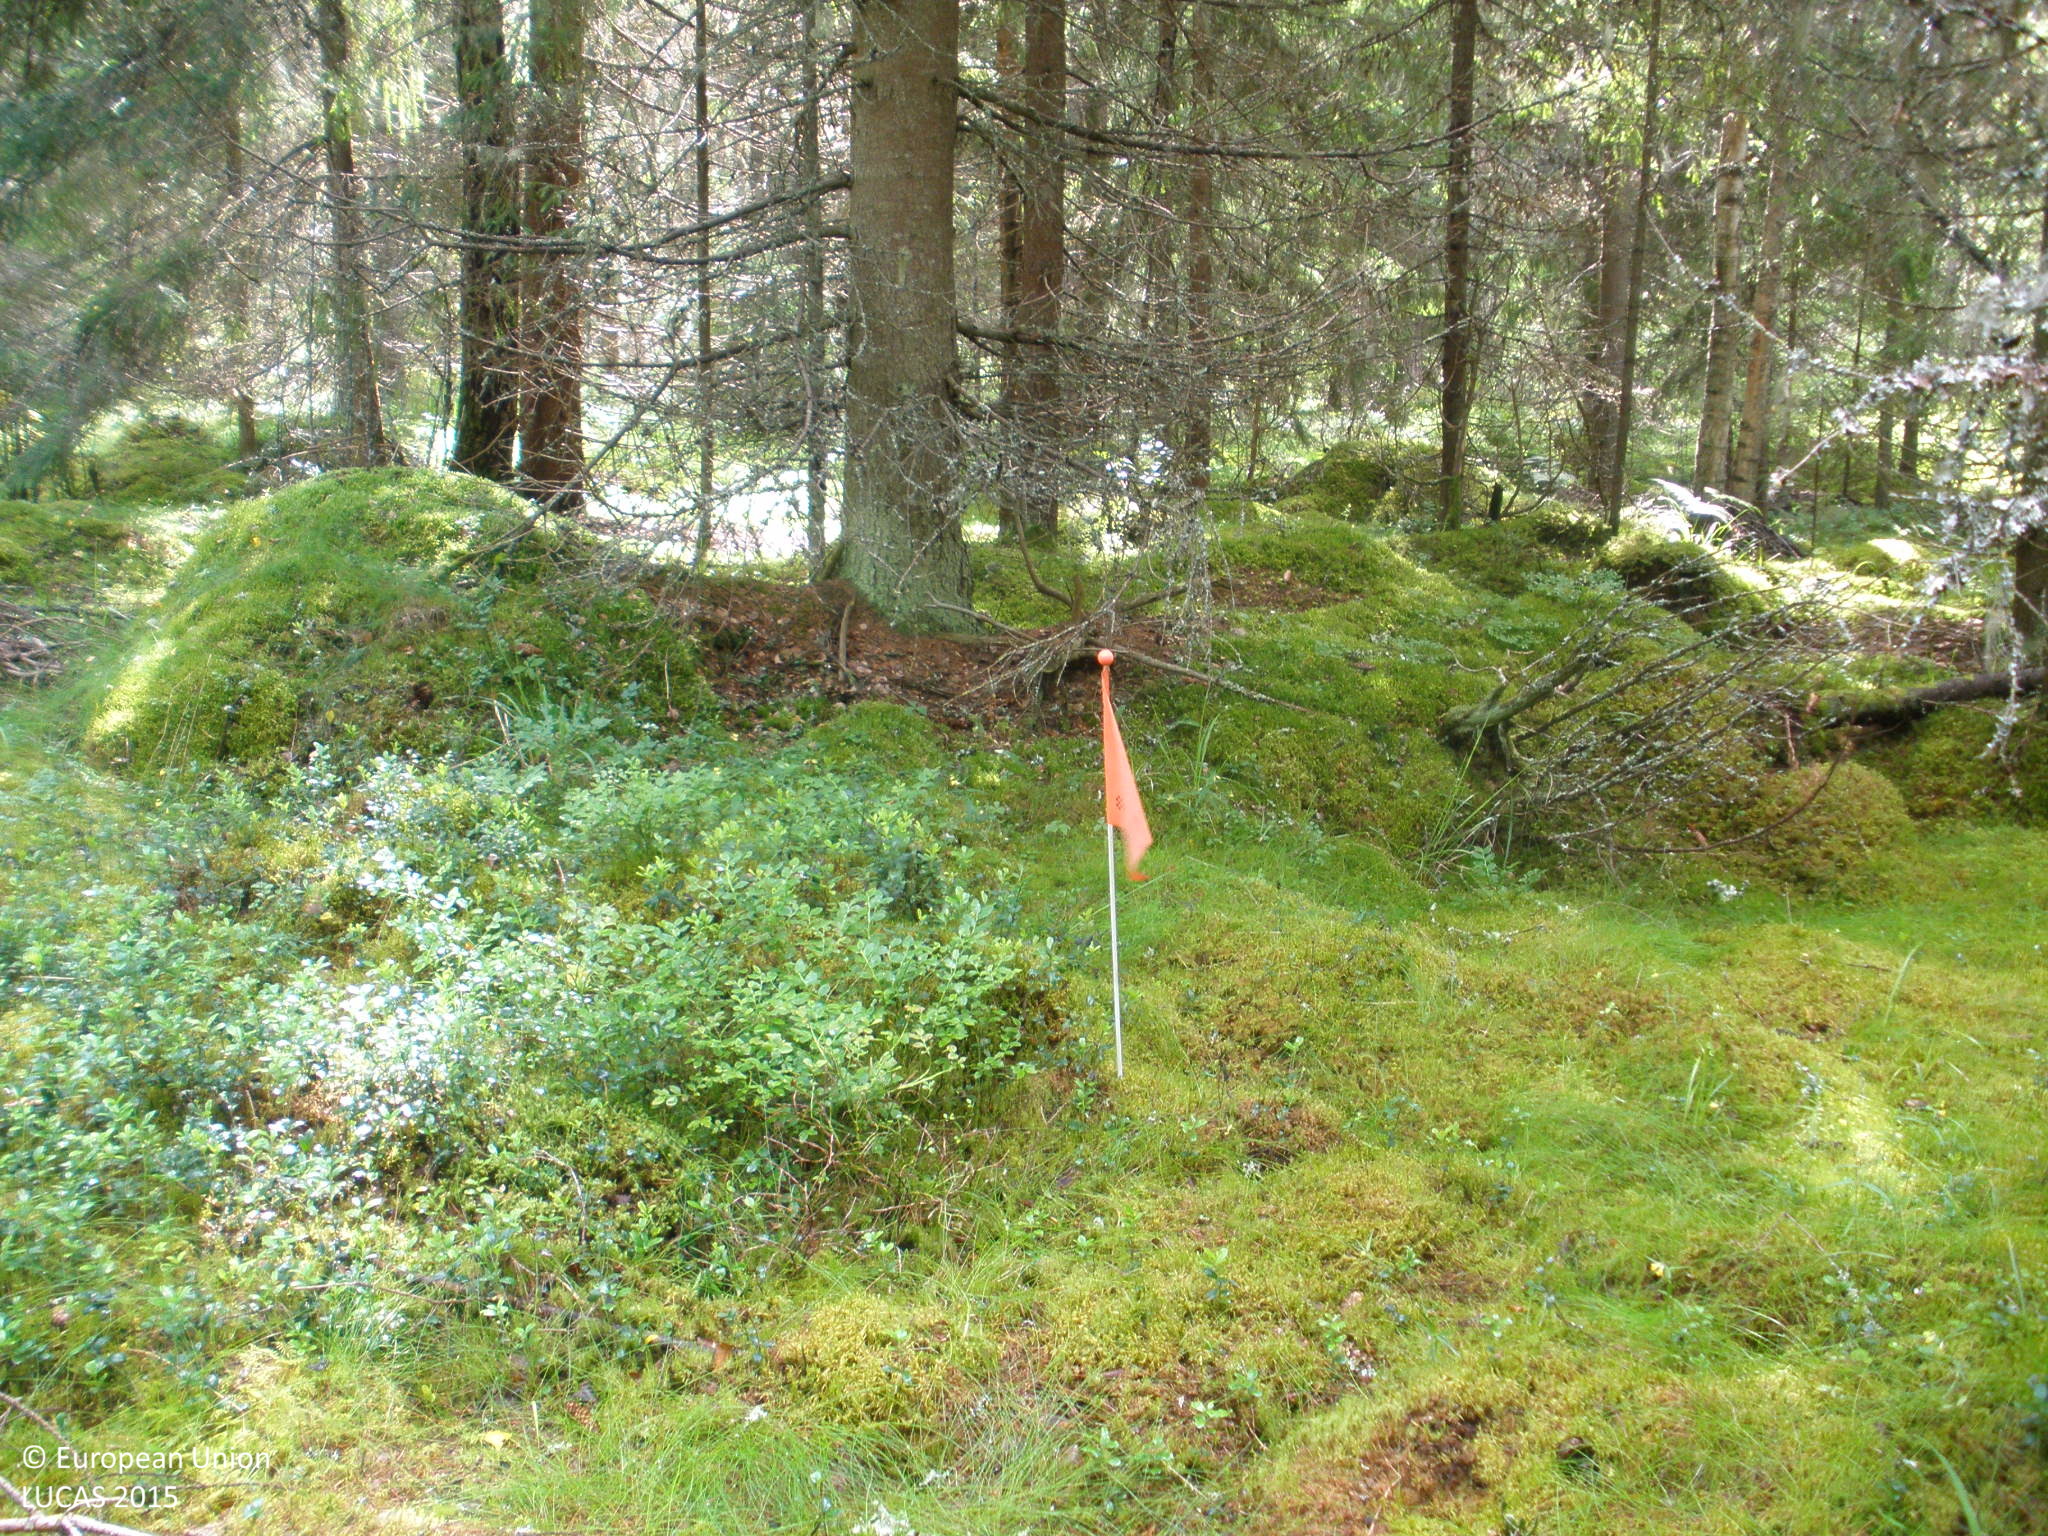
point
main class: Woodland
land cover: Spruce dominated coniferous woodland
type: boreal forest
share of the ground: > 75 %
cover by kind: coniferous forest trees 80 %, lichens and mosses 10 %, broadleaved forest trees 5 %, herbaceous plants 5 %
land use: Forestry
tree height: > 5 m
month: July
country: FI
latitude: 60.9902
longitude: 24.9940
